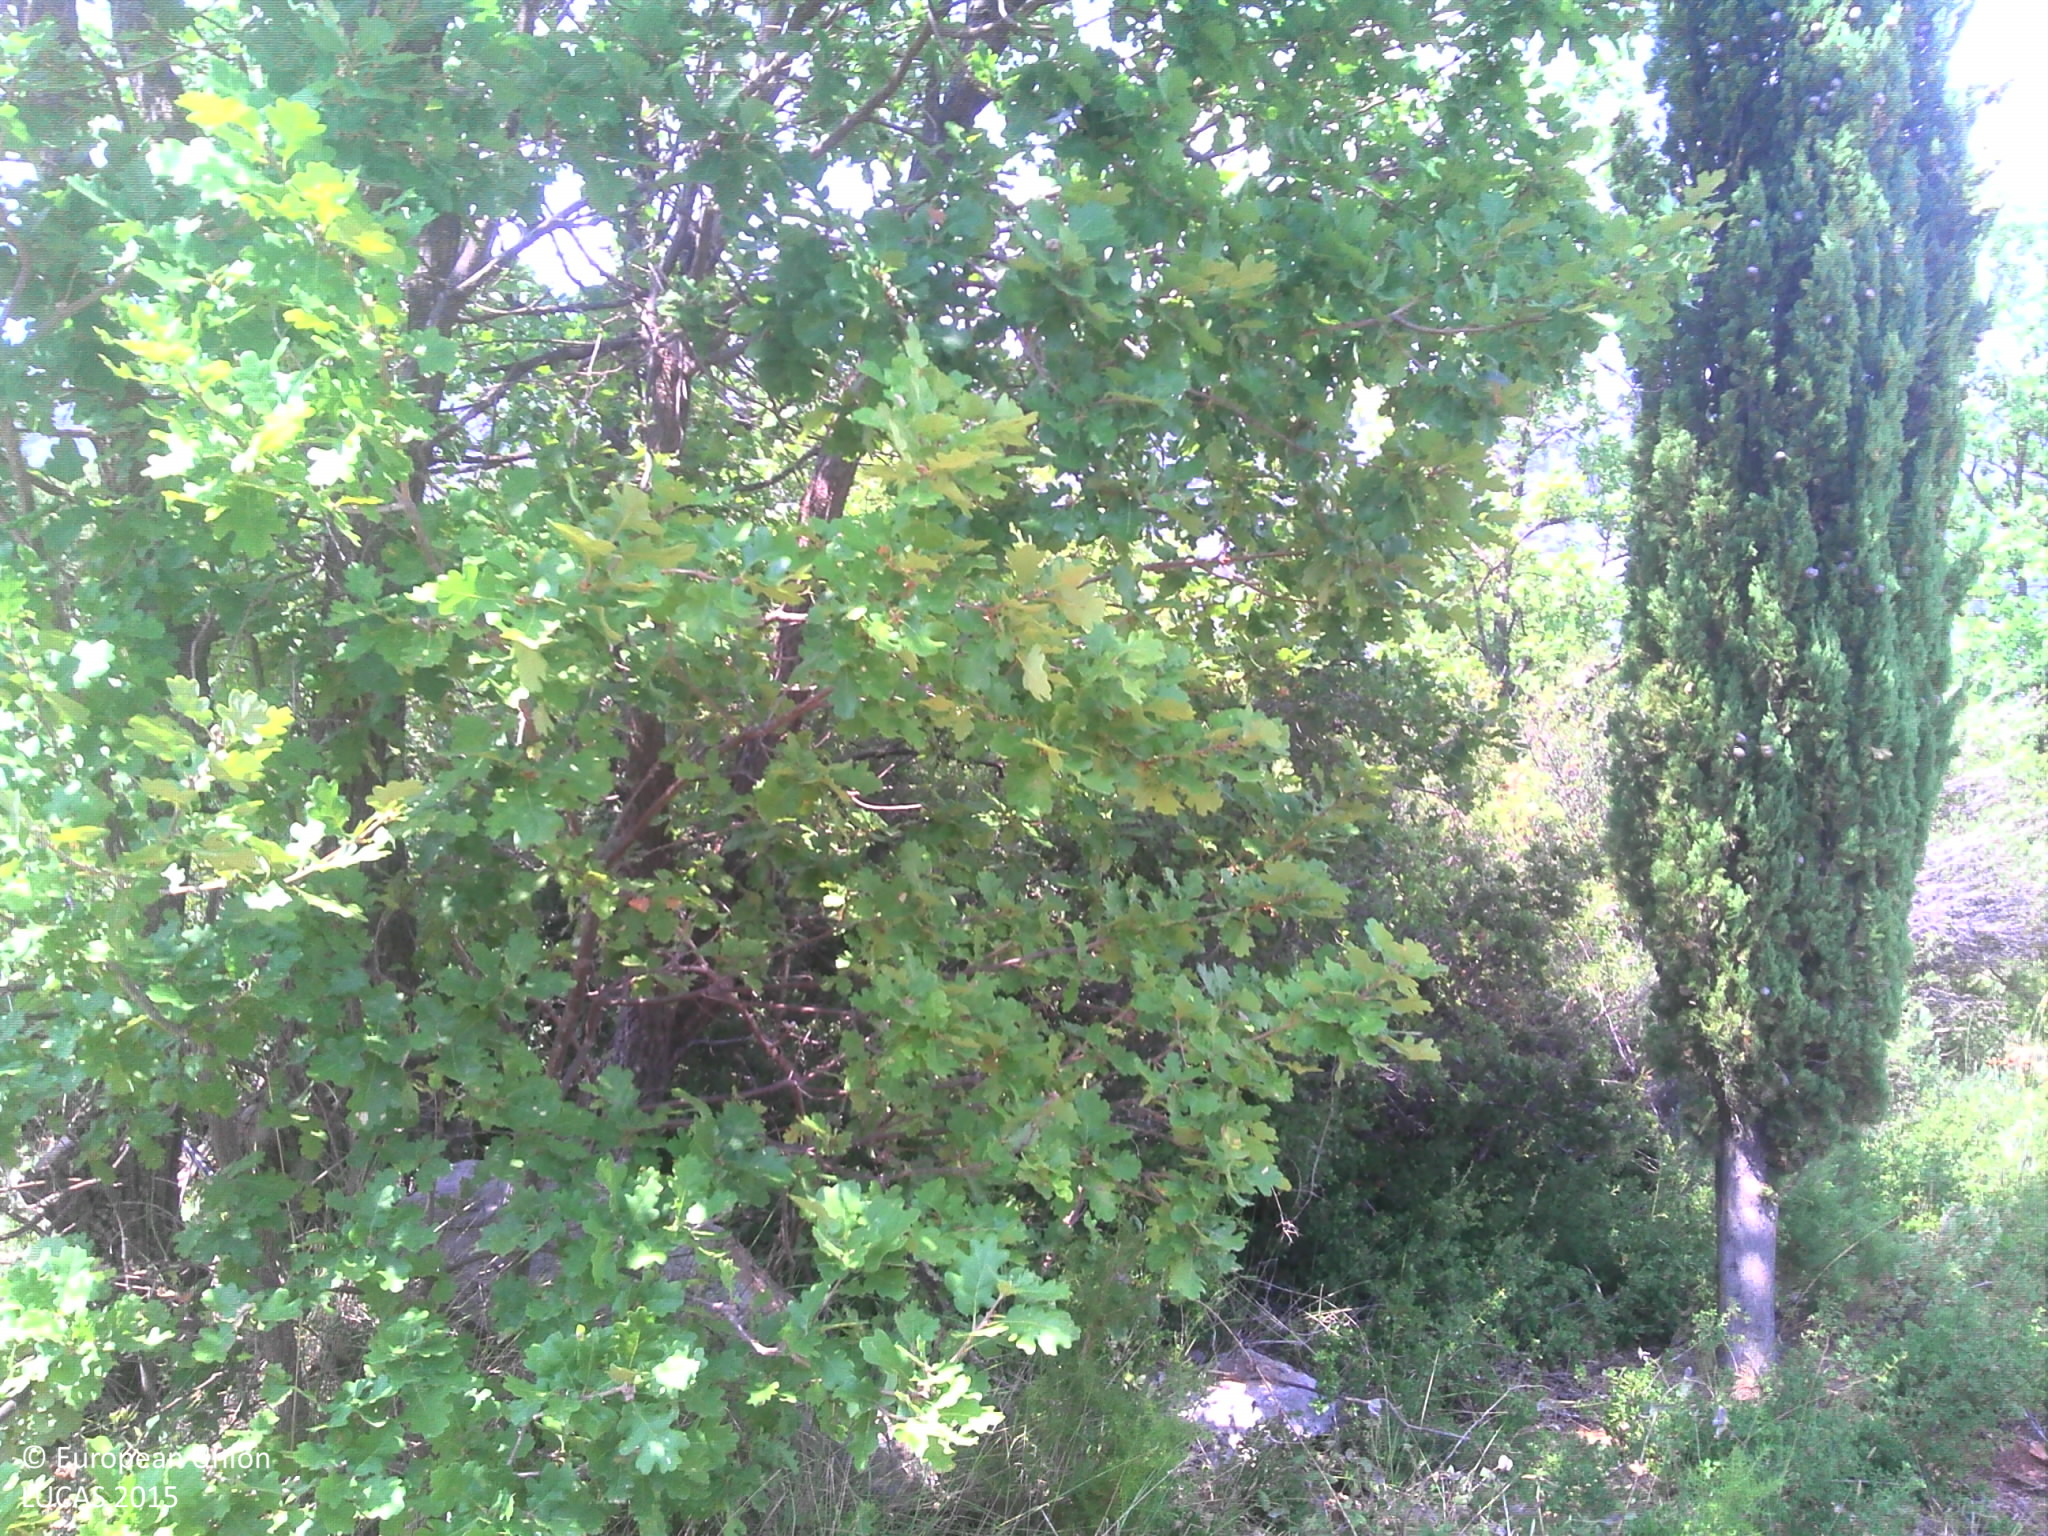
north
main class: Cropland
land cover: Olive groves
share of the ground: 25 - 50 %
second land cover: Other bare soil
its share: > 75 %
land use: Agriculture (excluding fallow land and kitchen gardens)
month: August
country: FR
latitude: 43.5184
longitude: 5.6425
